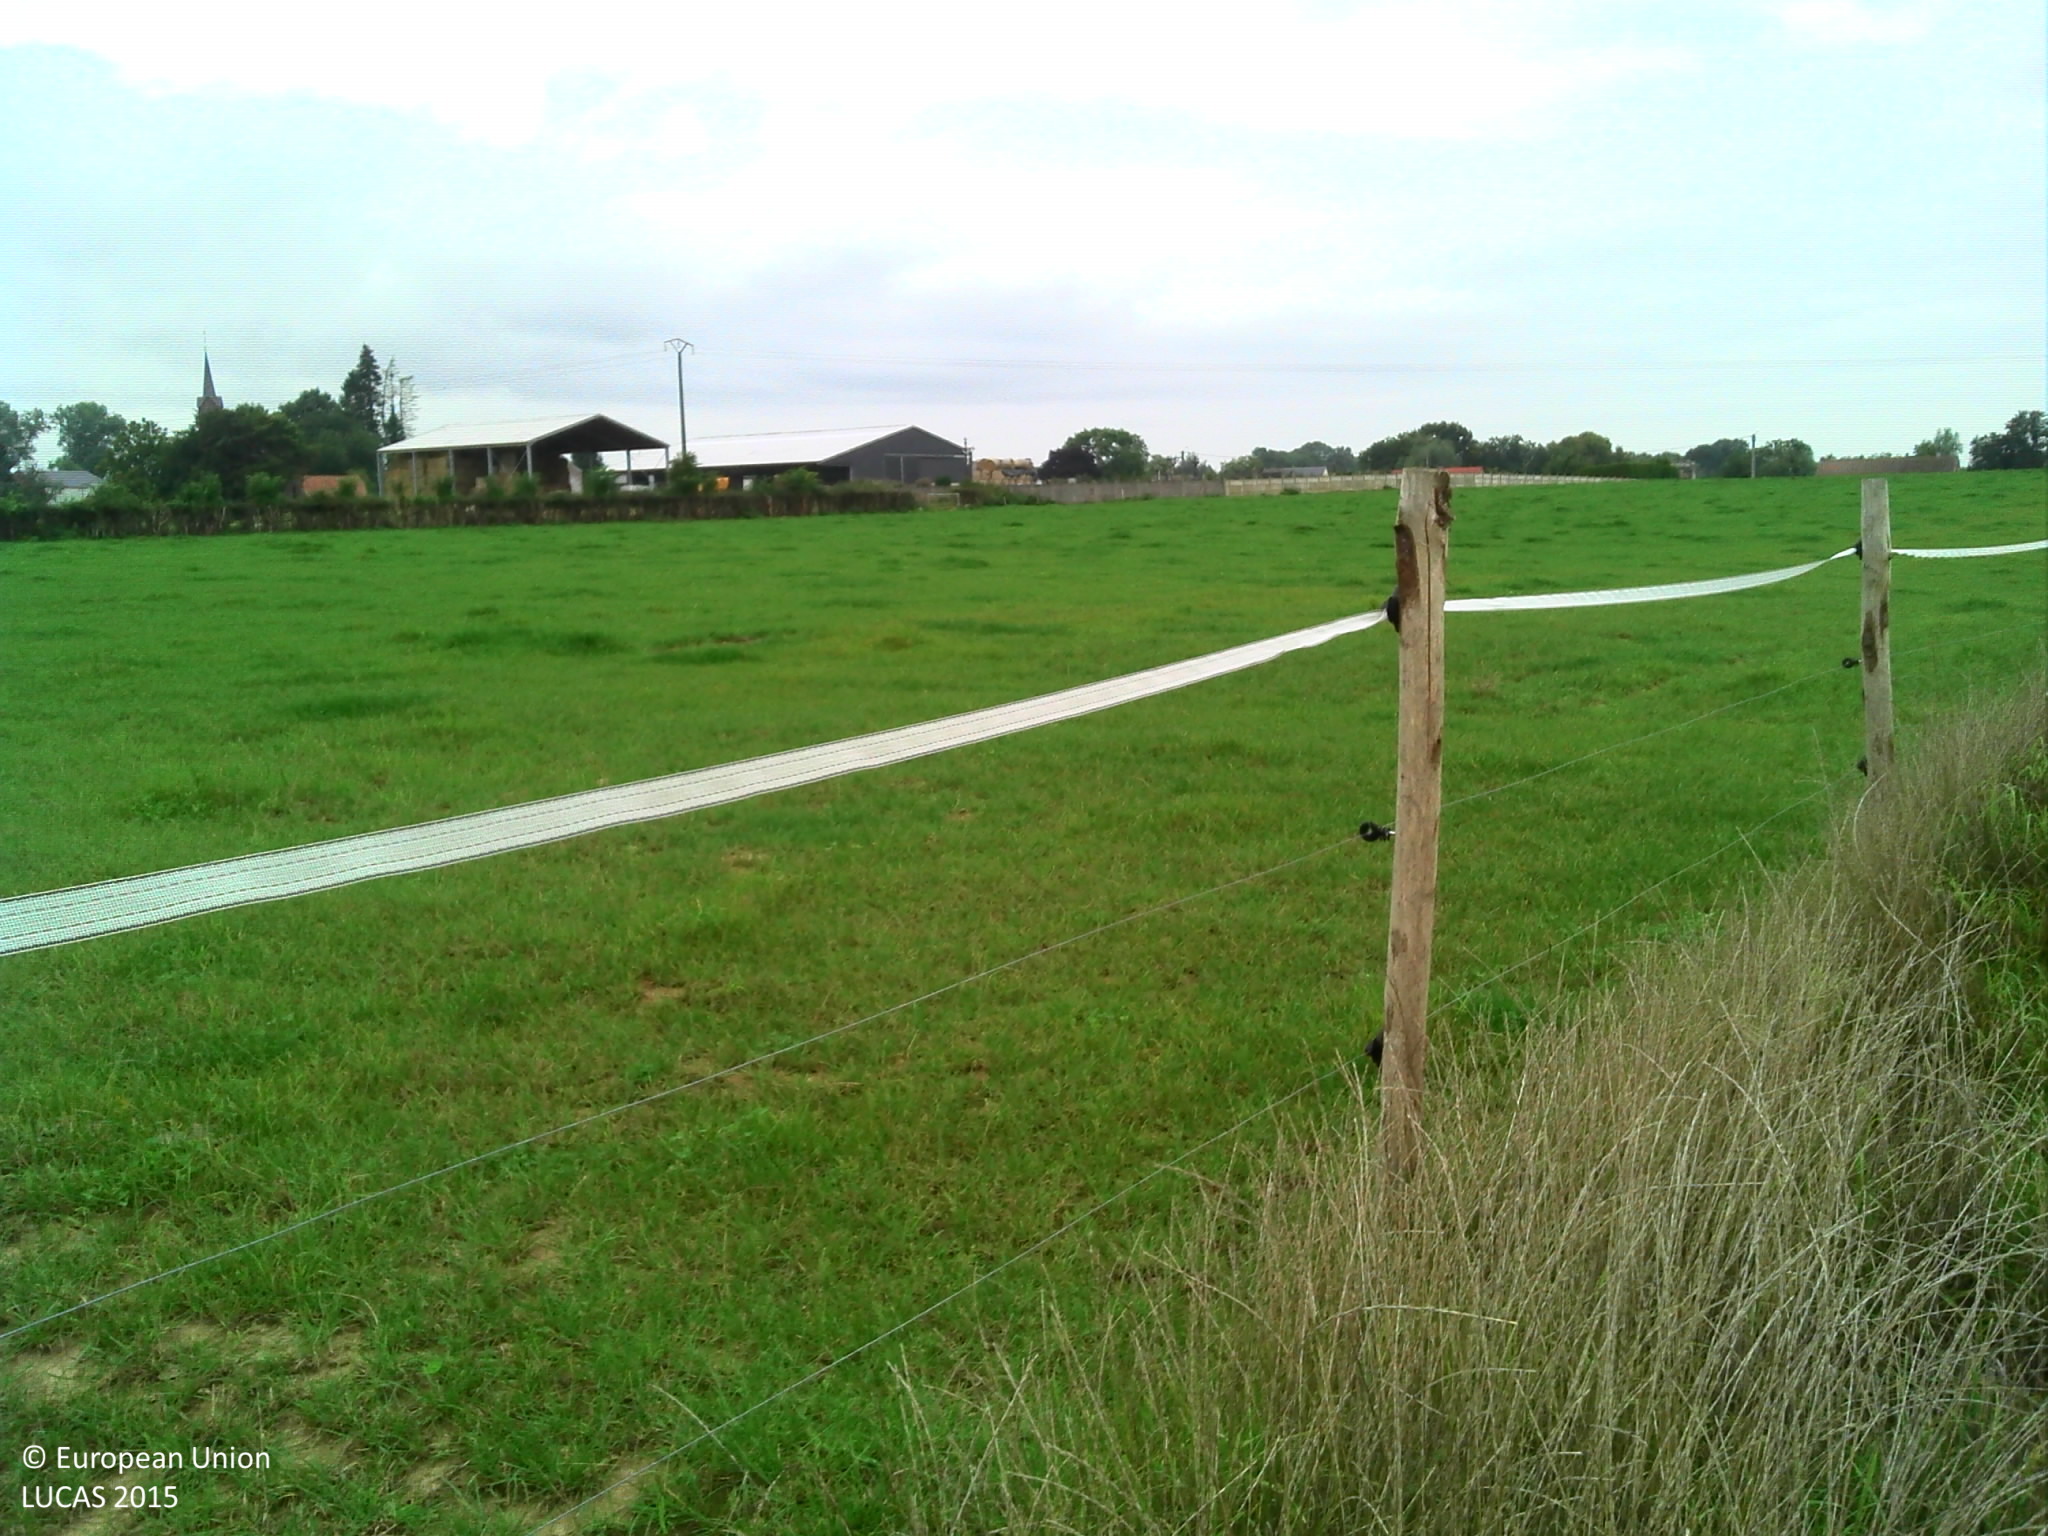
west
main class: Grassland
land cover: Grassland without tree/shrub cover
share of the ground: > 75 %
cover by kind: herbaceous plants 95 %, lichens and mosses 5 %
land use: Agriculture (excluding fallow land and kitchen gardens)
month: September
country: FR
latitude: 50.3147
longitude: 3.9978
